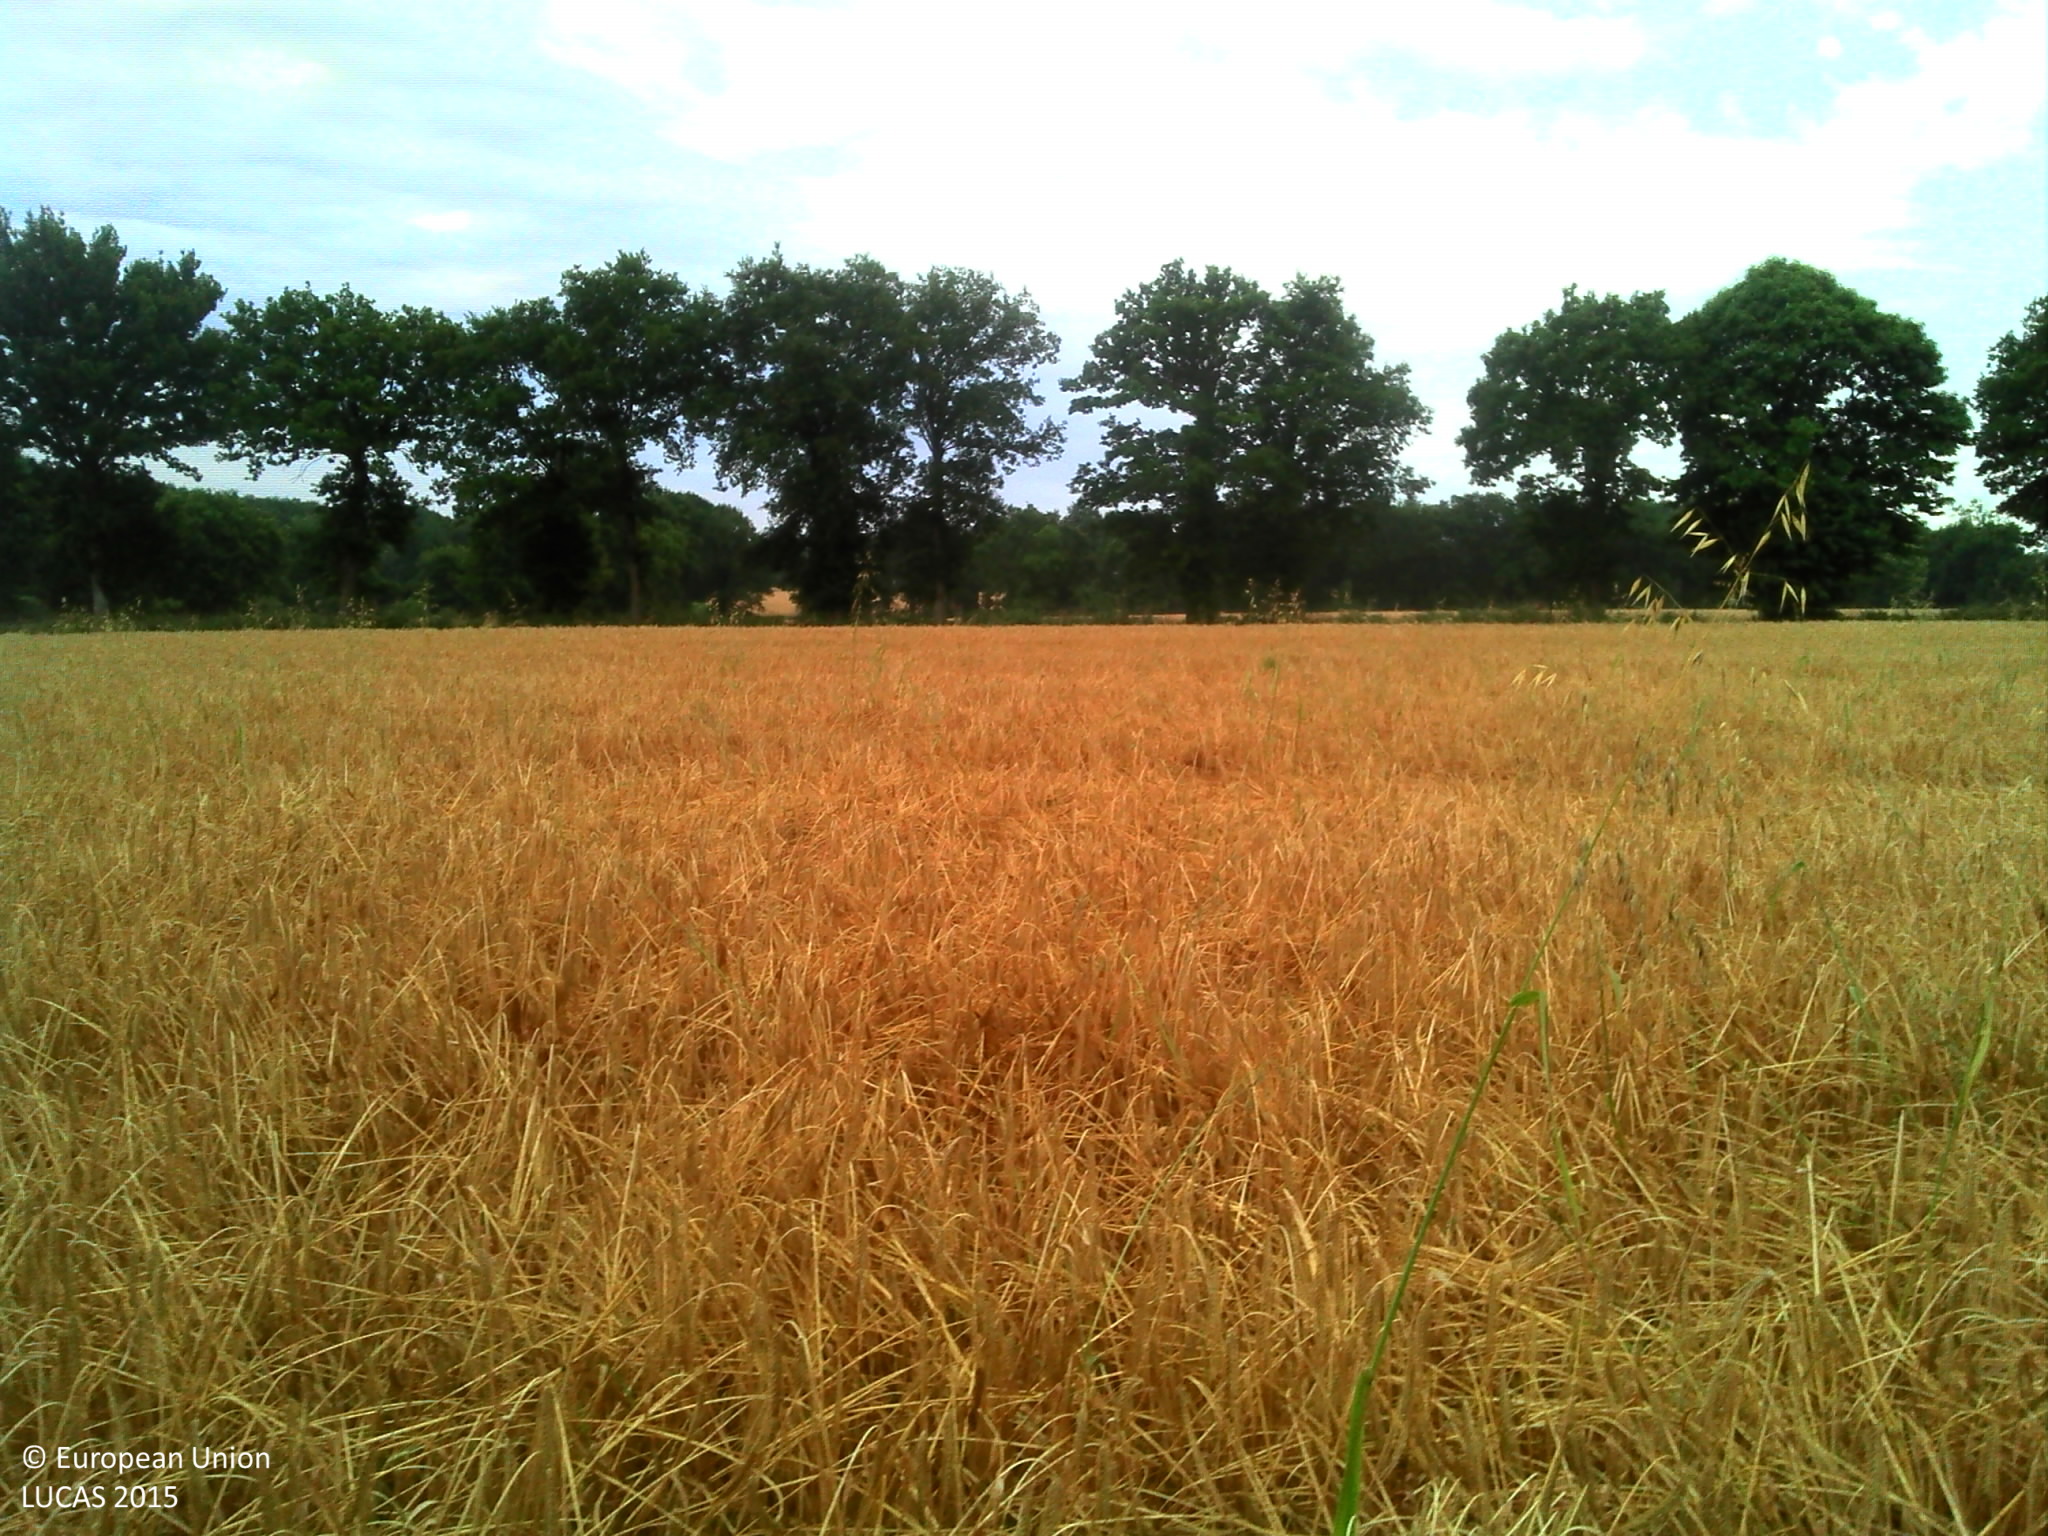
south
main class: Cropland
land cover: Barley
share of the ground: > 75 %
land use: Agriculture (excluding fallow land and kitchen gardens)
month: July
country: FR
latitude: 48.3265
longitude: -1.6889
